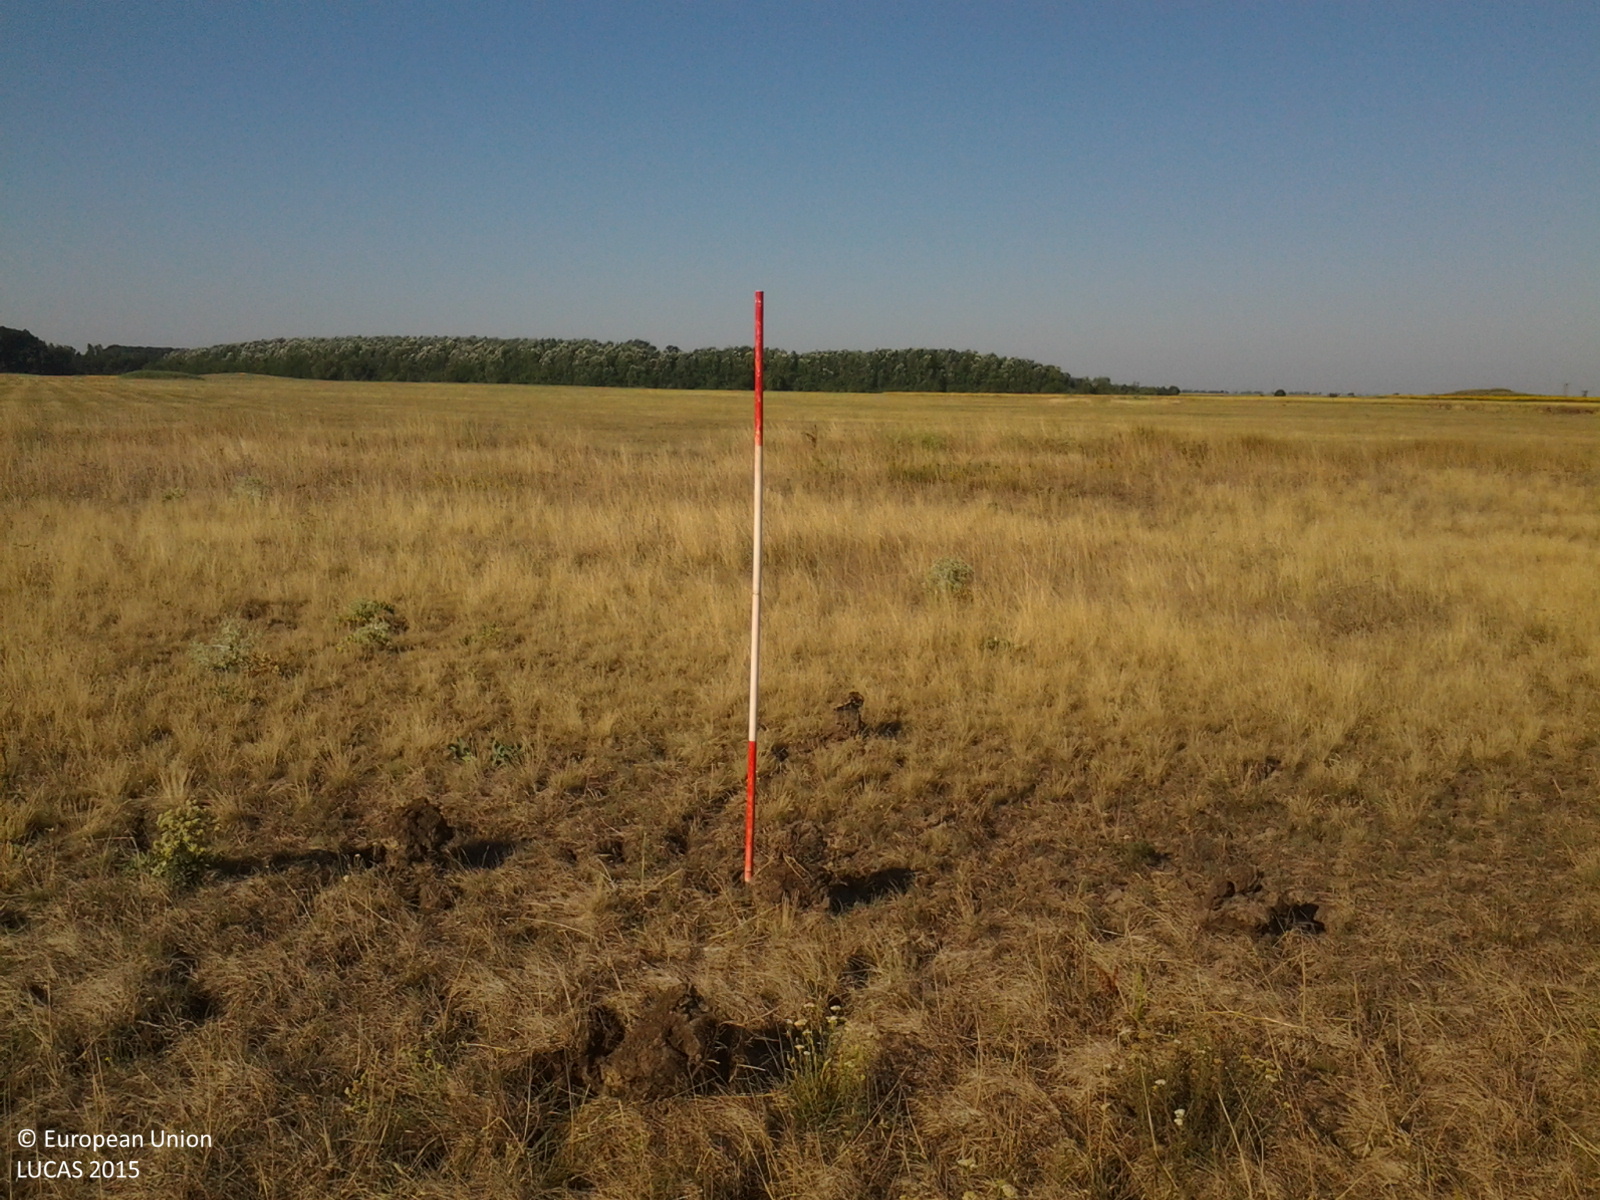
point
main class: Grassland
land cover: Grassland without tree/shrub cover
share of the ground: > 75 %
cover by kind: herbaceous plants 100 %
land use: Agriculture (excluding fallow land and kitchen gardens)
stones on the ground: < 10 %
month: July
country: HU
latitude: 47.0696
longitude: 20.8440
